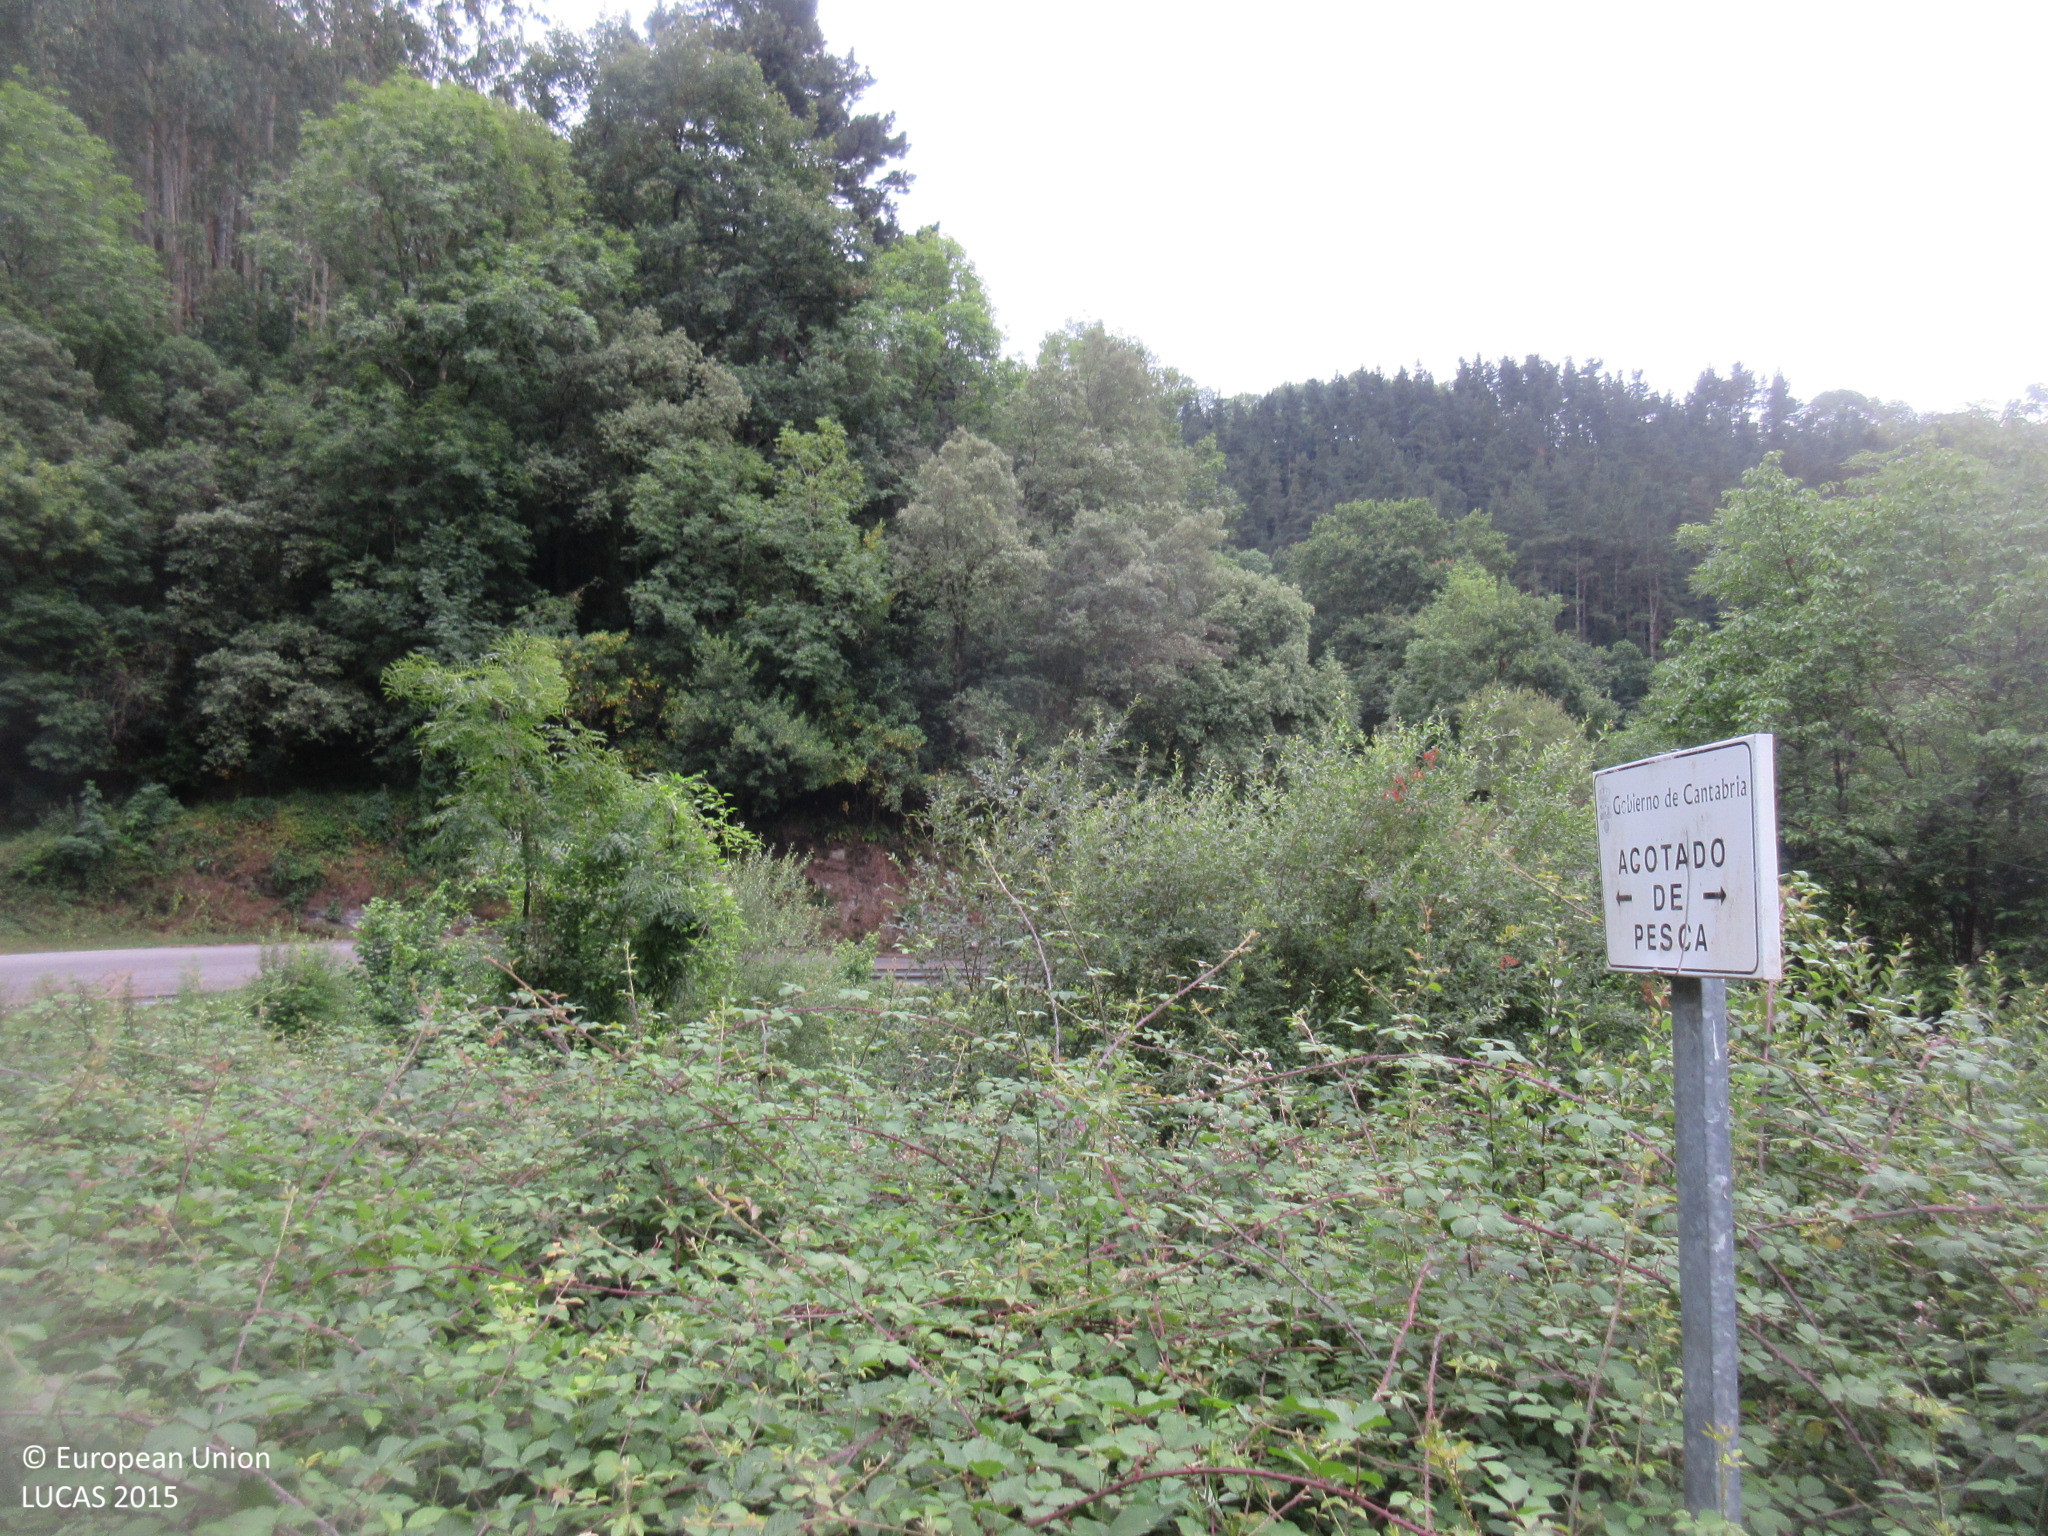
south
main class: Woodland
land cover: Broadleaved woodland
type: acidophilous oak and oak-birch forest
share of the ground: > 75 %
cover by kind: broadleaved forest trees 90 %, shrubs 10 %
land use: Semi-natural and natural areas not in use
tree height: > 5 m
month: July
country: ES
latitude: 43.2118
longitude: -3.4707
